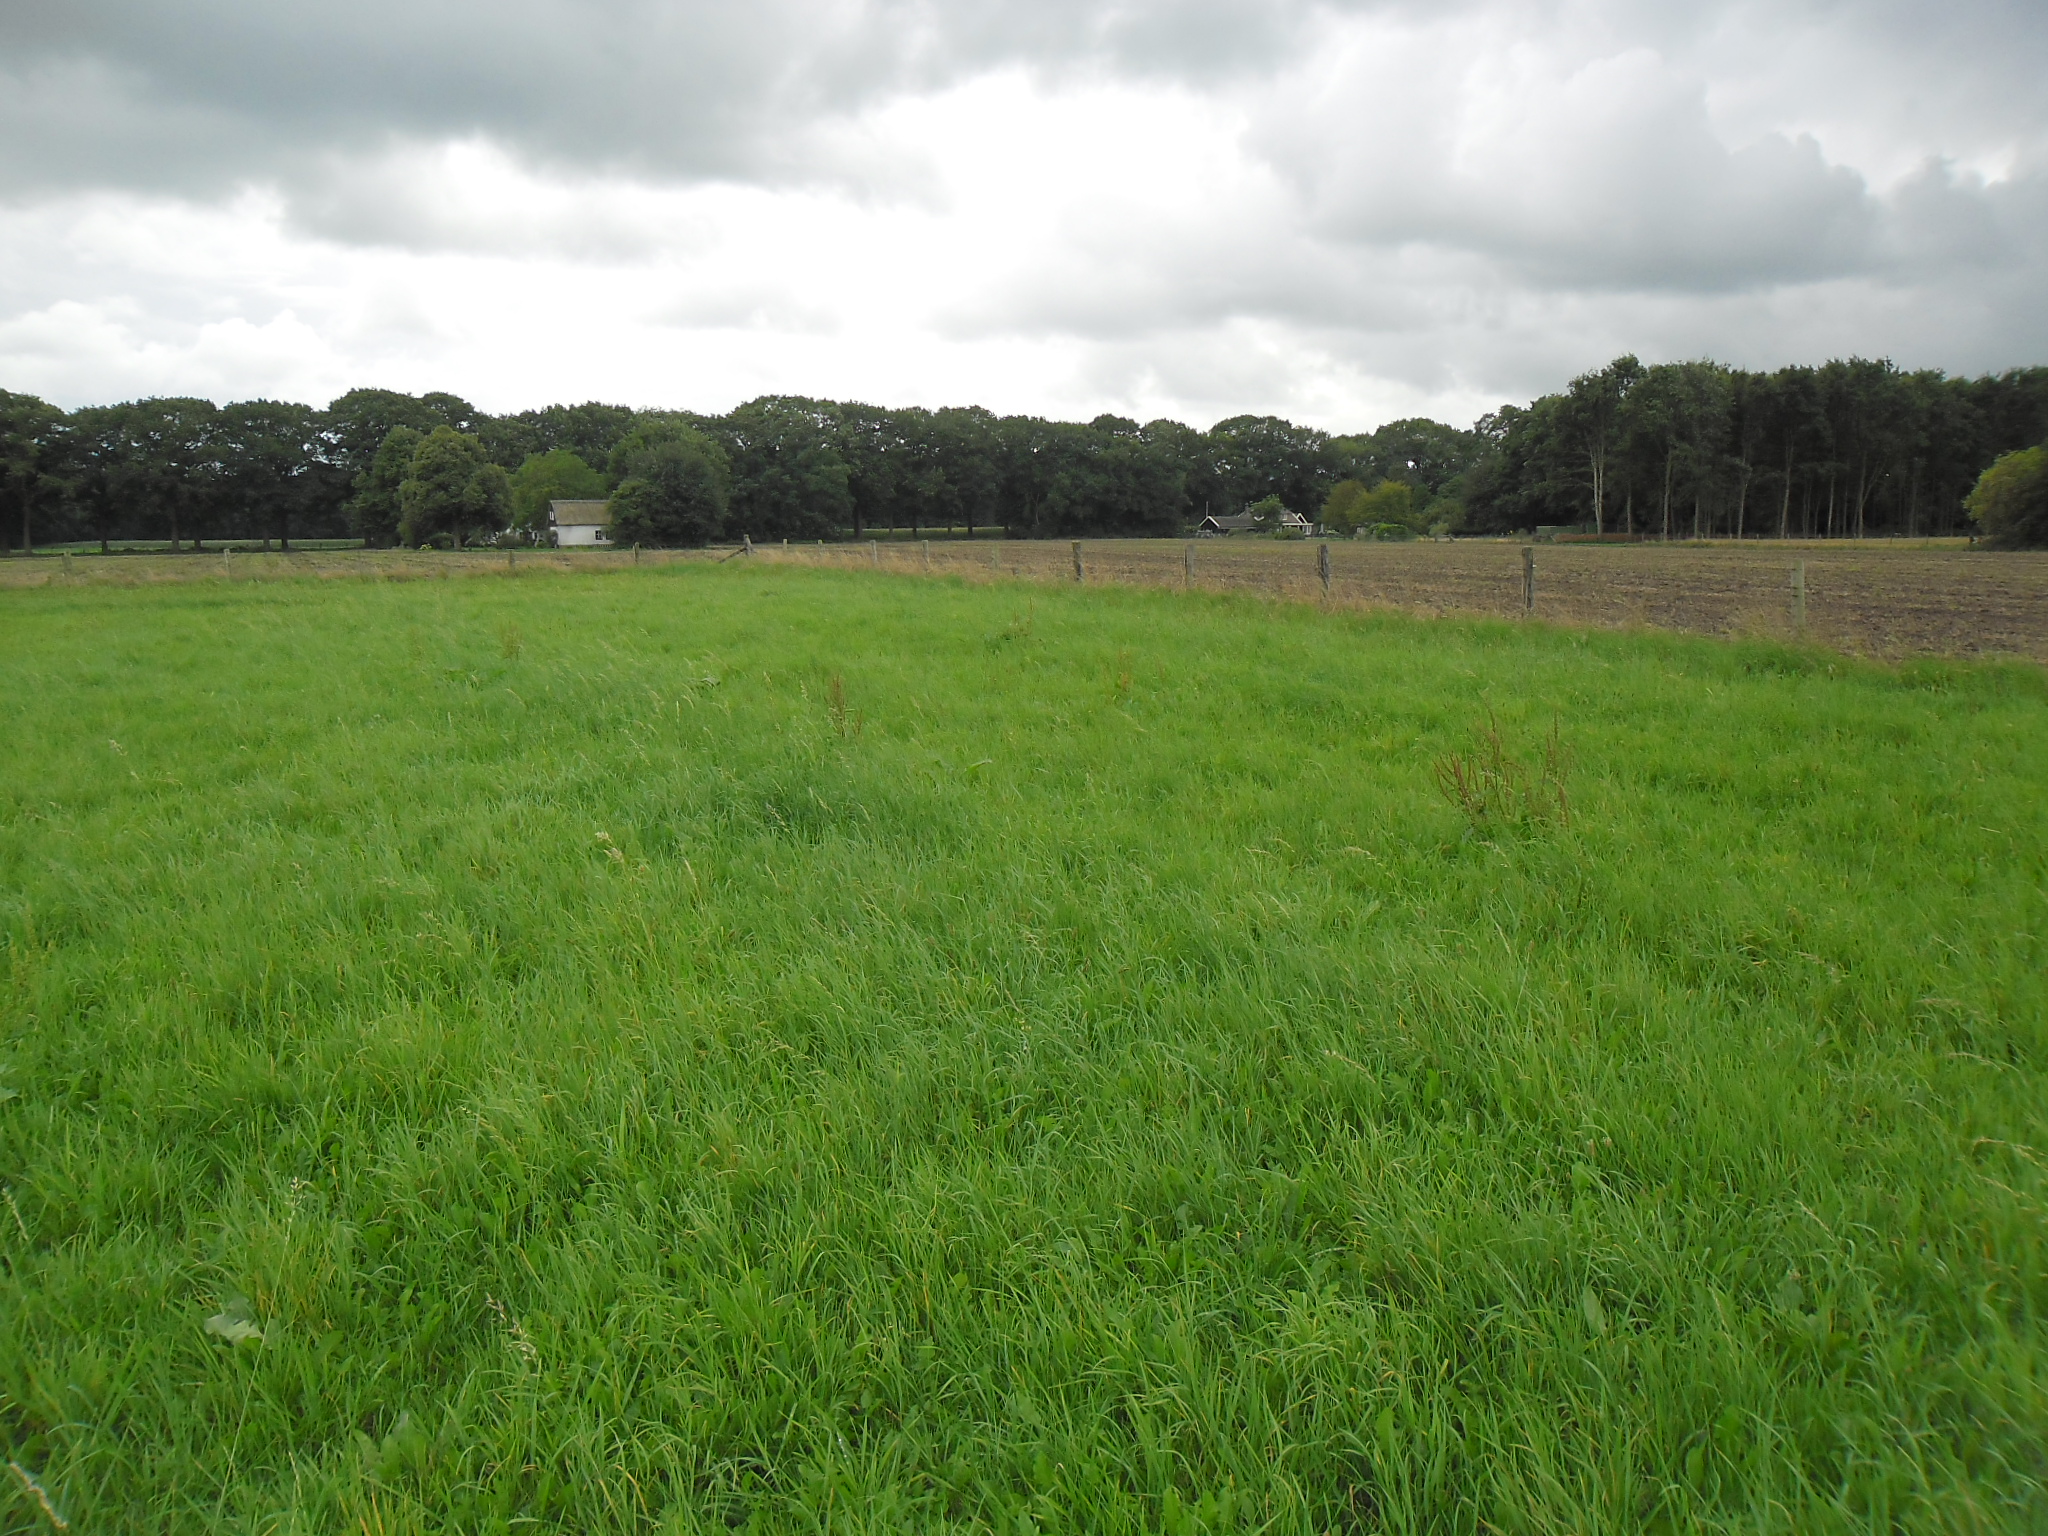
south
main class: Grassland
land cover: Grassland without tree/shrub cover
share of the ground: > 75 %
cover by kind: herbaceous plants 100 %
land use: Agriculture (excluding fallow land and kitchen gardens)
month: September
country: NL
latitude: 52.2090
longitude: 6.2091
